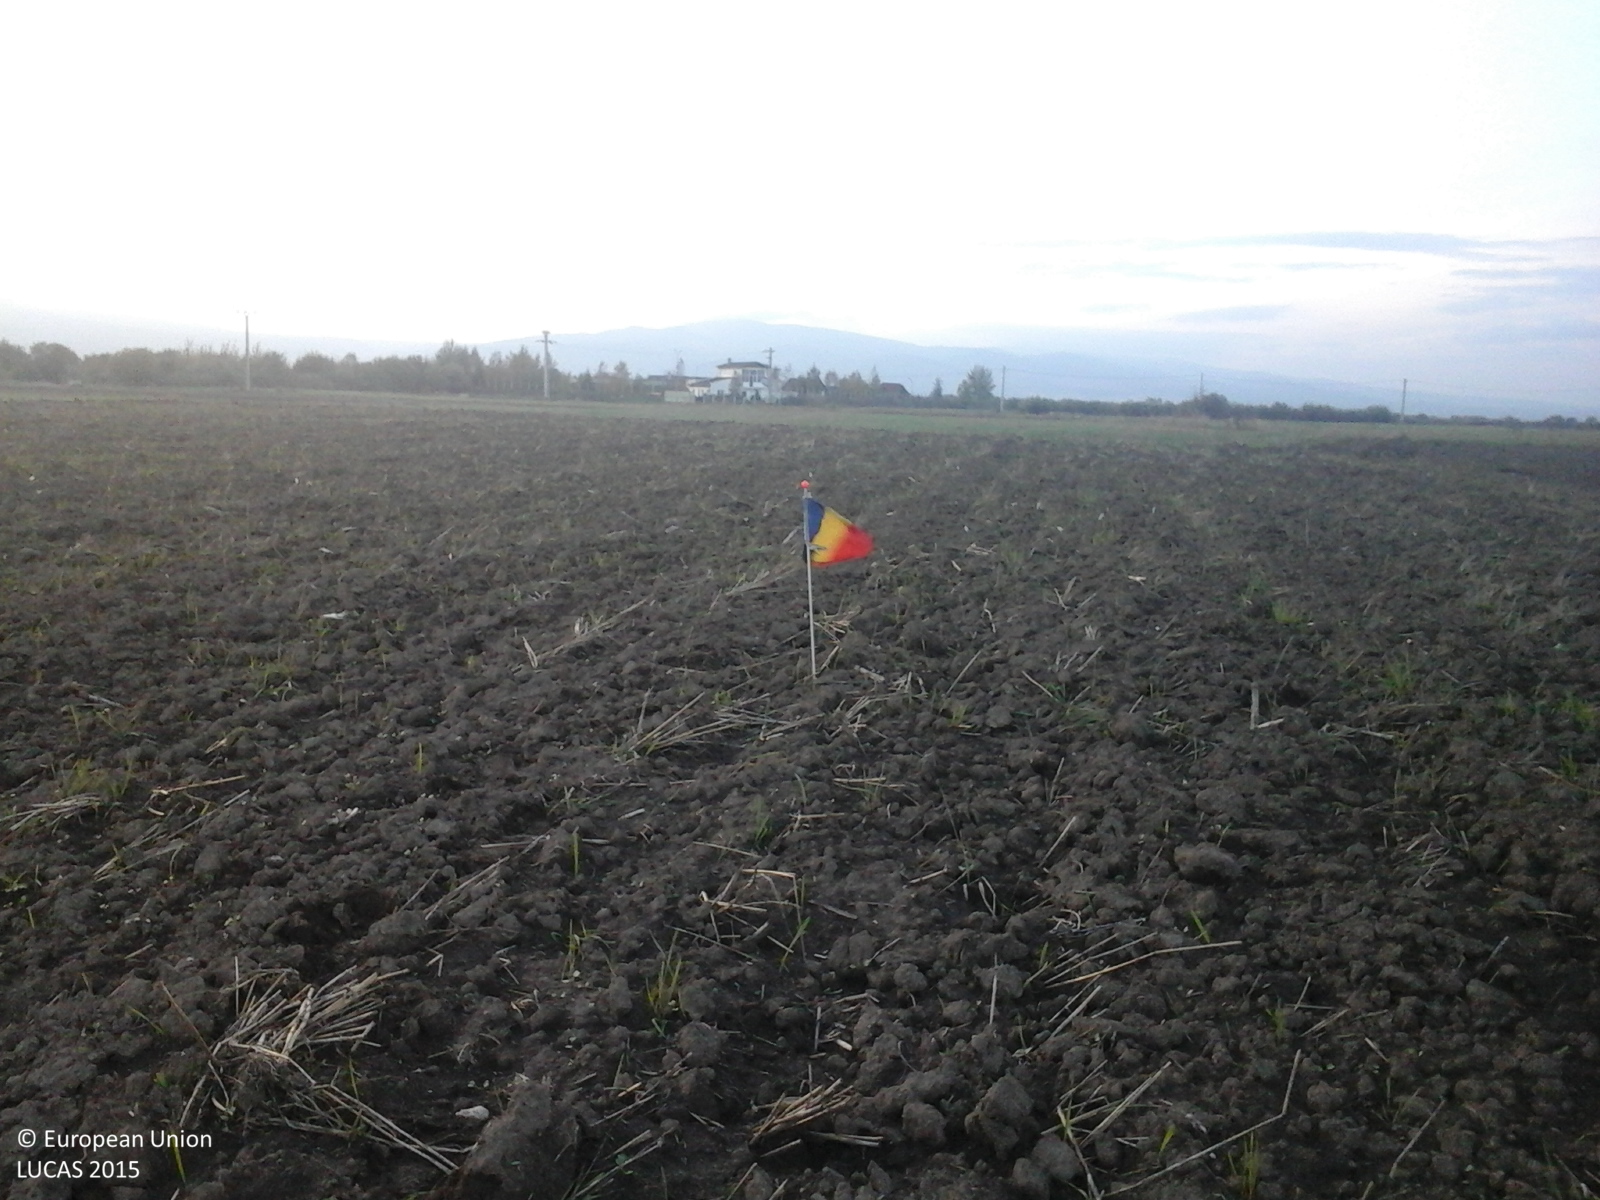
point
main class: Cropland
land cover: Common wheat
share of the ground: < 10 %
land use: Agriculture (excluding fallow land and kitchen gardens)
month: October
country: RO
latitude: 46.7005
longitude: 25.4768
